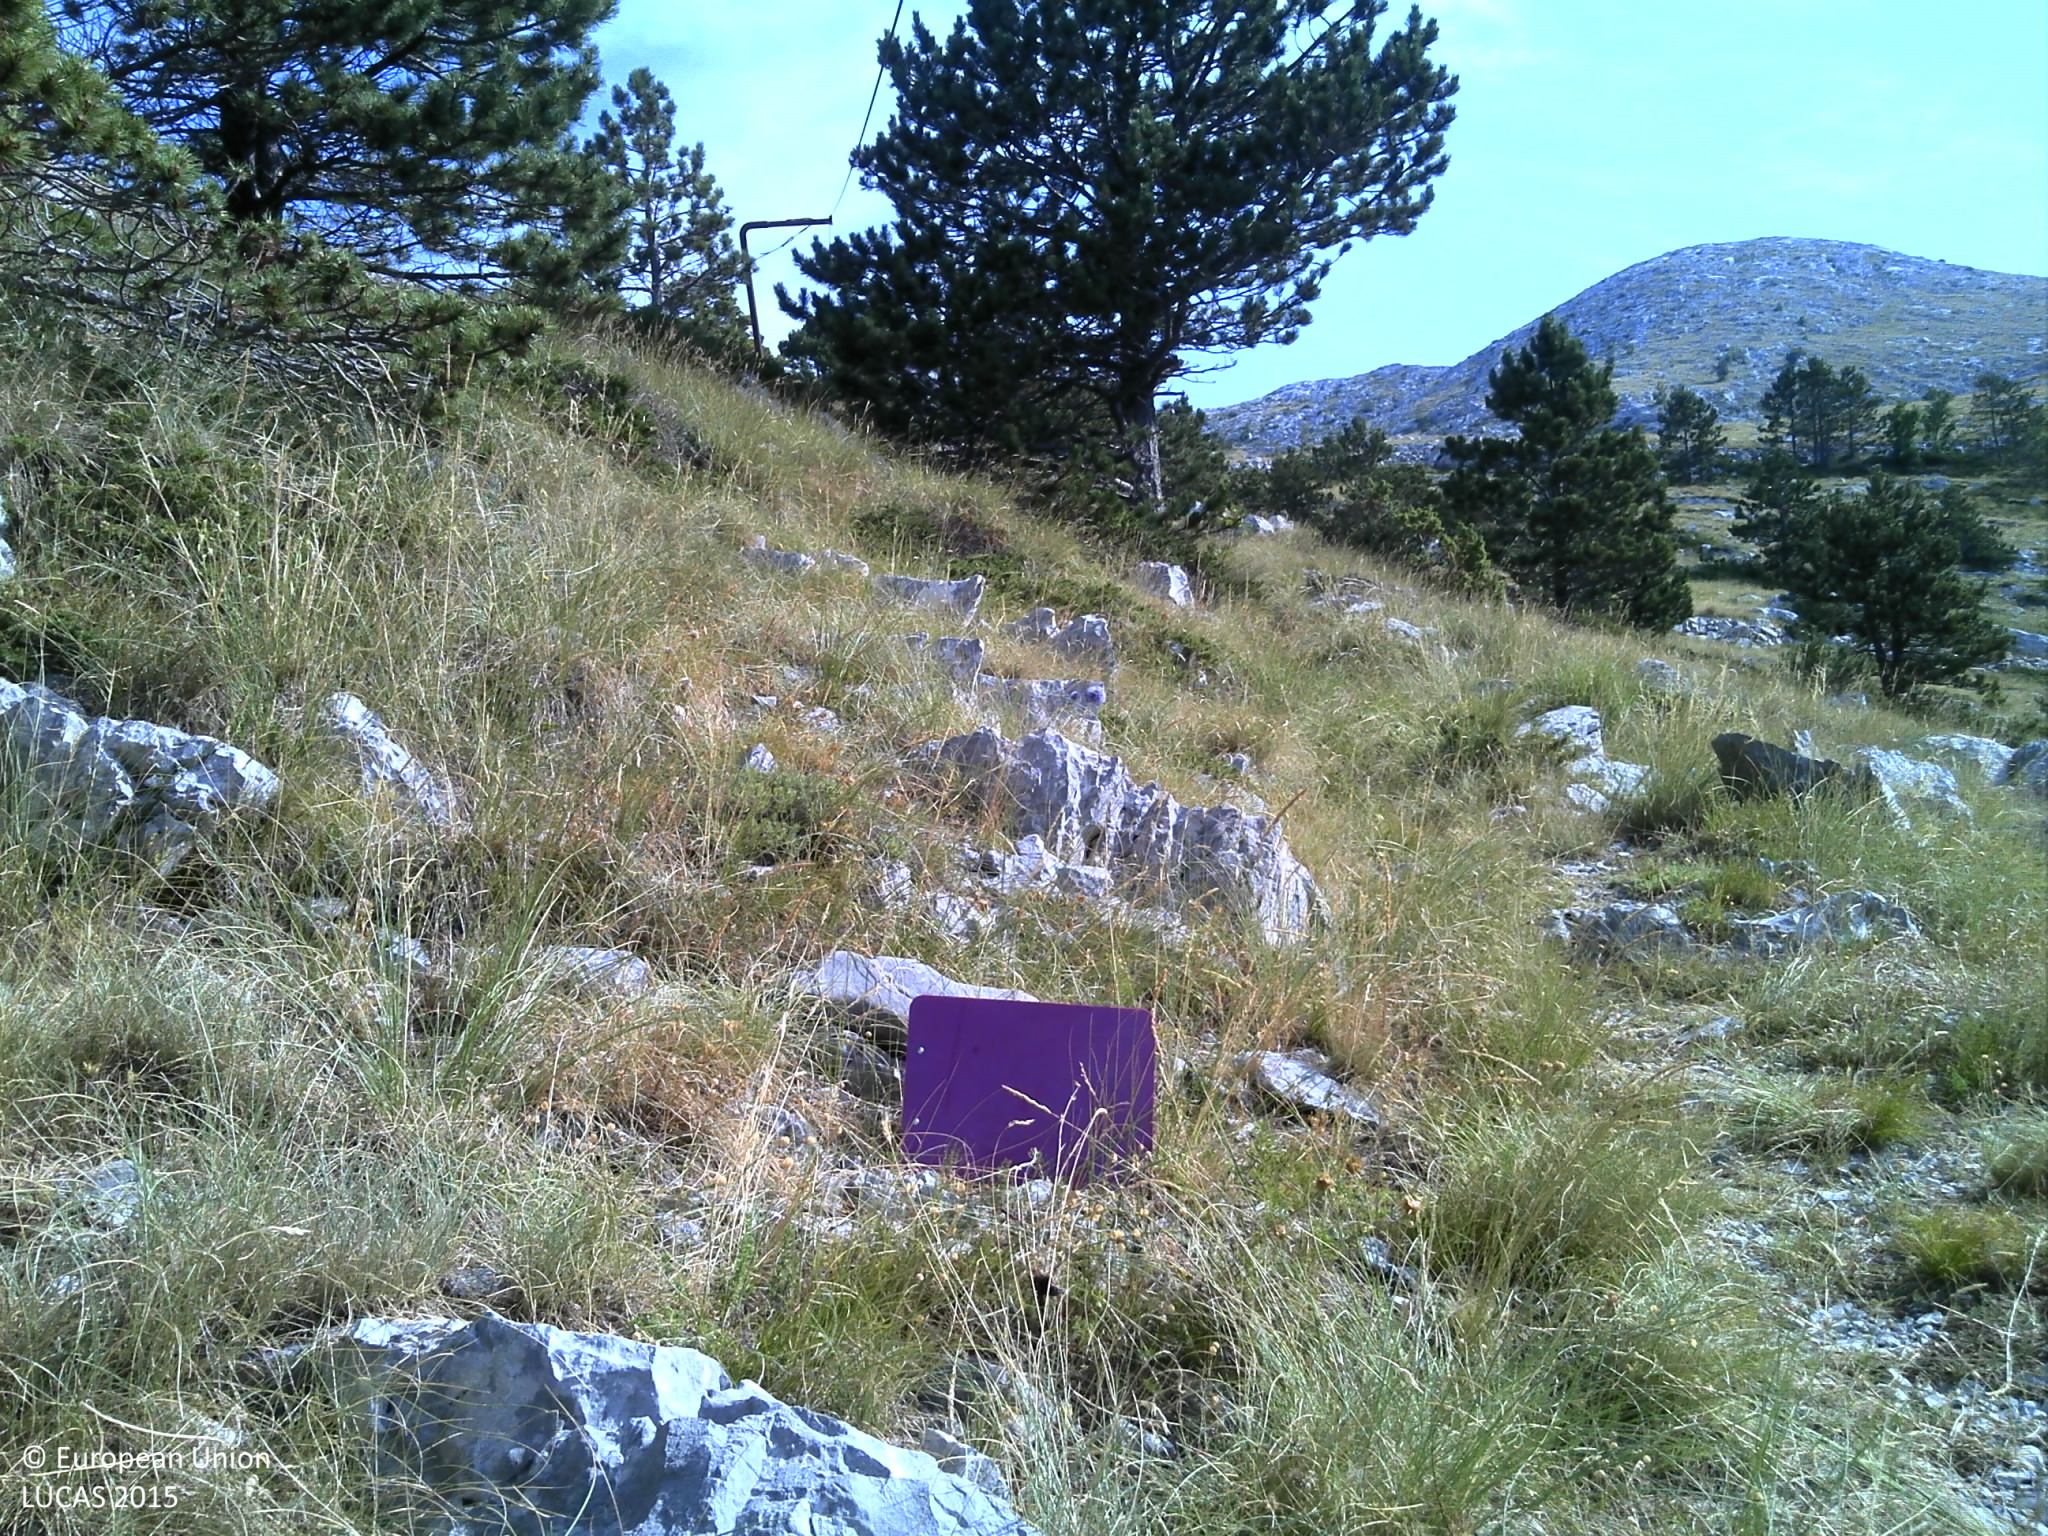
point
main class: Woodland
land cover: Pine dominated coniferous woodland
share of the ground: 10 - 25 %
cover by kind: herbaceous plants 60 %, coniferous forest trees 15 %, shrubs 10 %, unconsolidated bare surface 10 %, consolidated bare surface 5 %
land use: Semi-natural and natural areas not in use
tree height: > 5 m
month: August
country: HR
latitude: 43.2940
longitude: 17.0782
